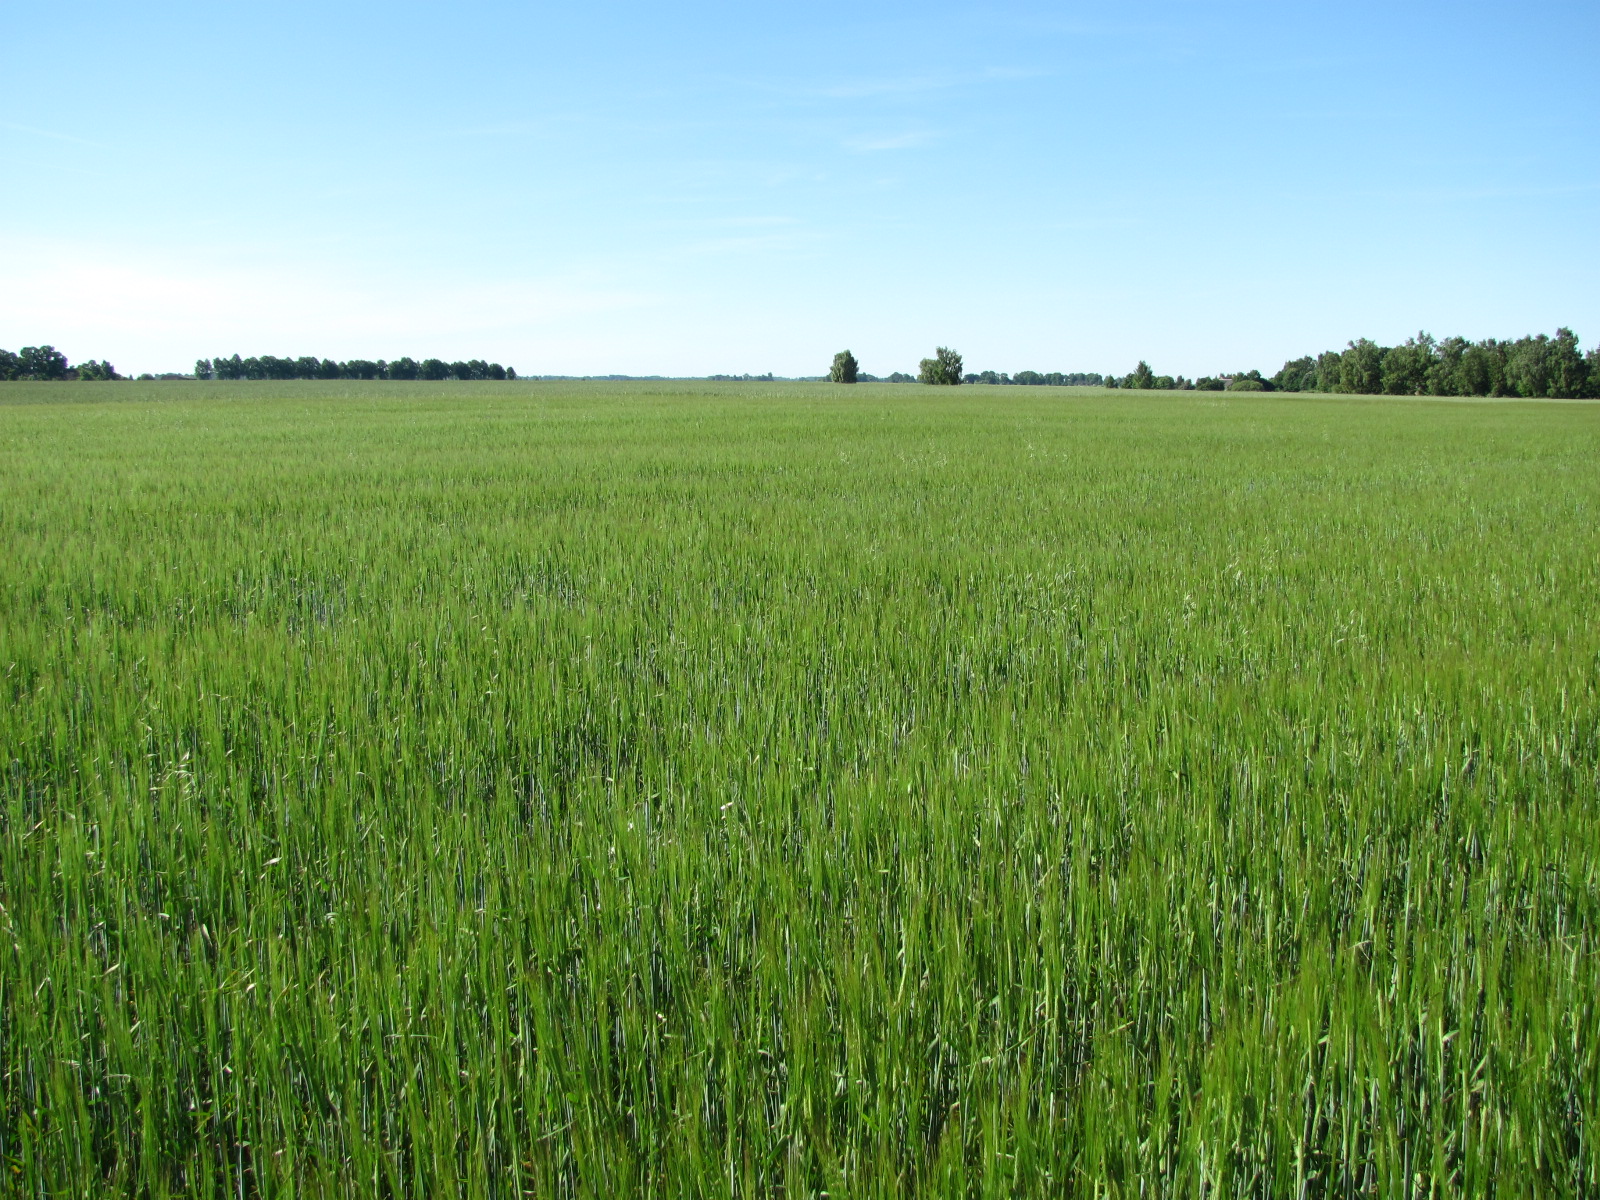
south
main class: Cropland
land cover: Barley
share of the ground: > 75 %
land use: Agriculture (excluding fallow land and kitchen gardens)
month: July
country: LV
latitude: 56.4895
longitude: 23.8710
